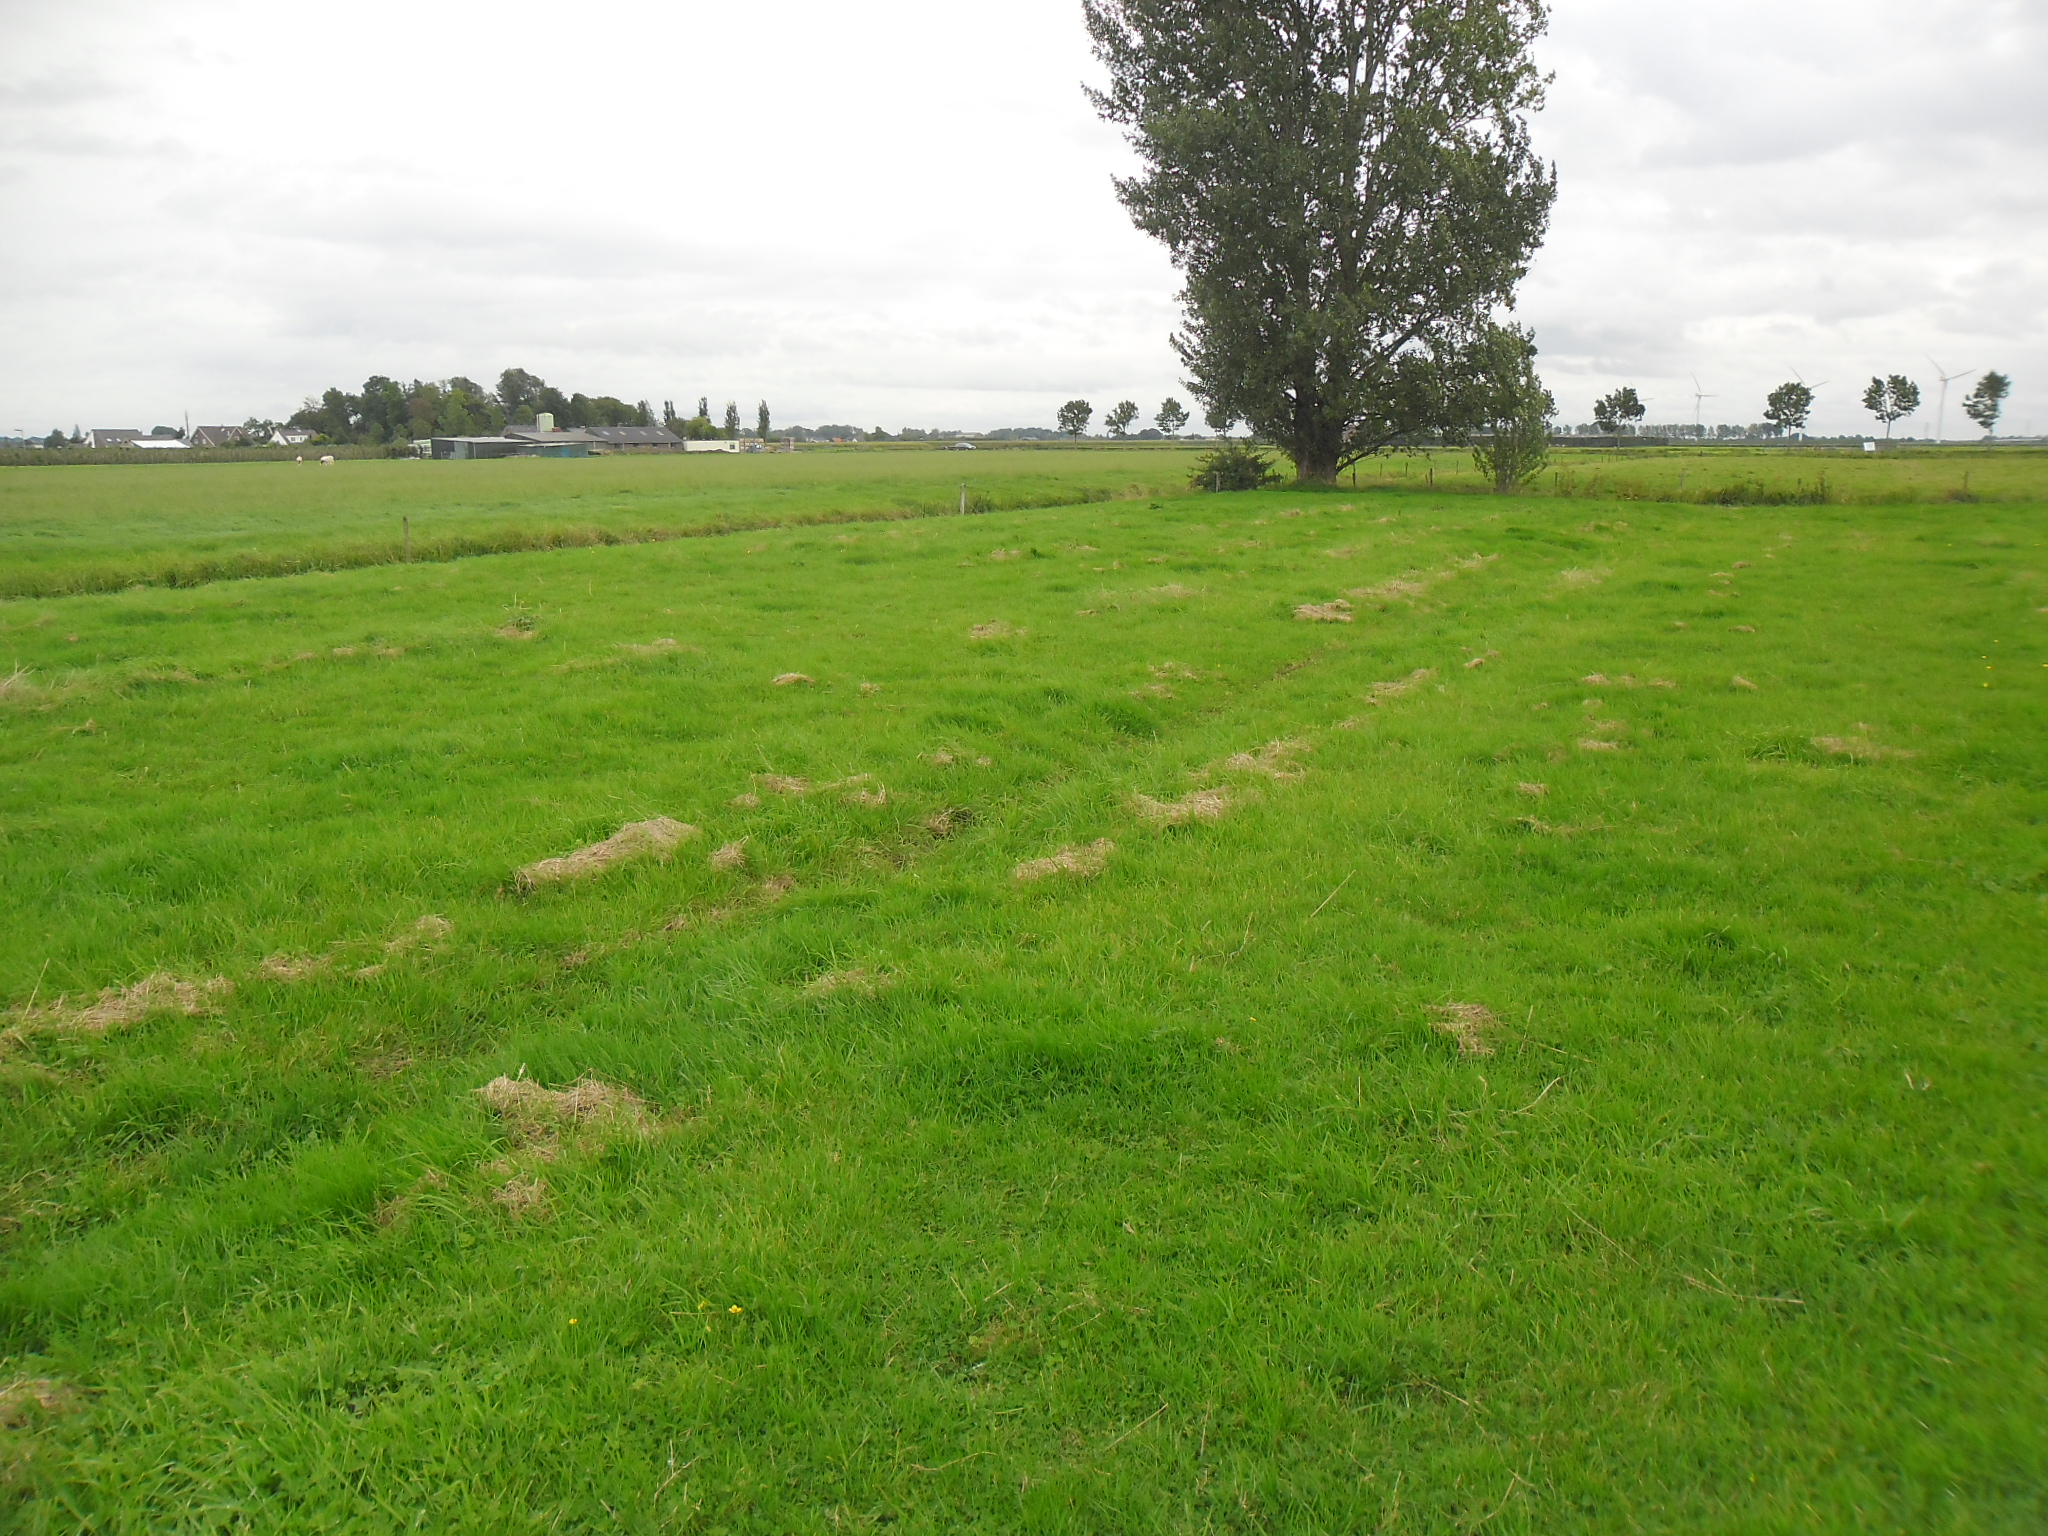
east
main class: Grassland
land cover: Grassland without tree/shrub cover
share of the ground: > 75 %
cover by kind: herbaceous plants 100 %
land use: Agriculture (excluding fallow land and kitchen gardens)
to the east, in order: Grassland without tree/shrub cover; Fences; Inland fresh running water; Grassland without tree/shrub cover
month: September
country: NL
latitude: 51.9323
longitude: 5.5042
